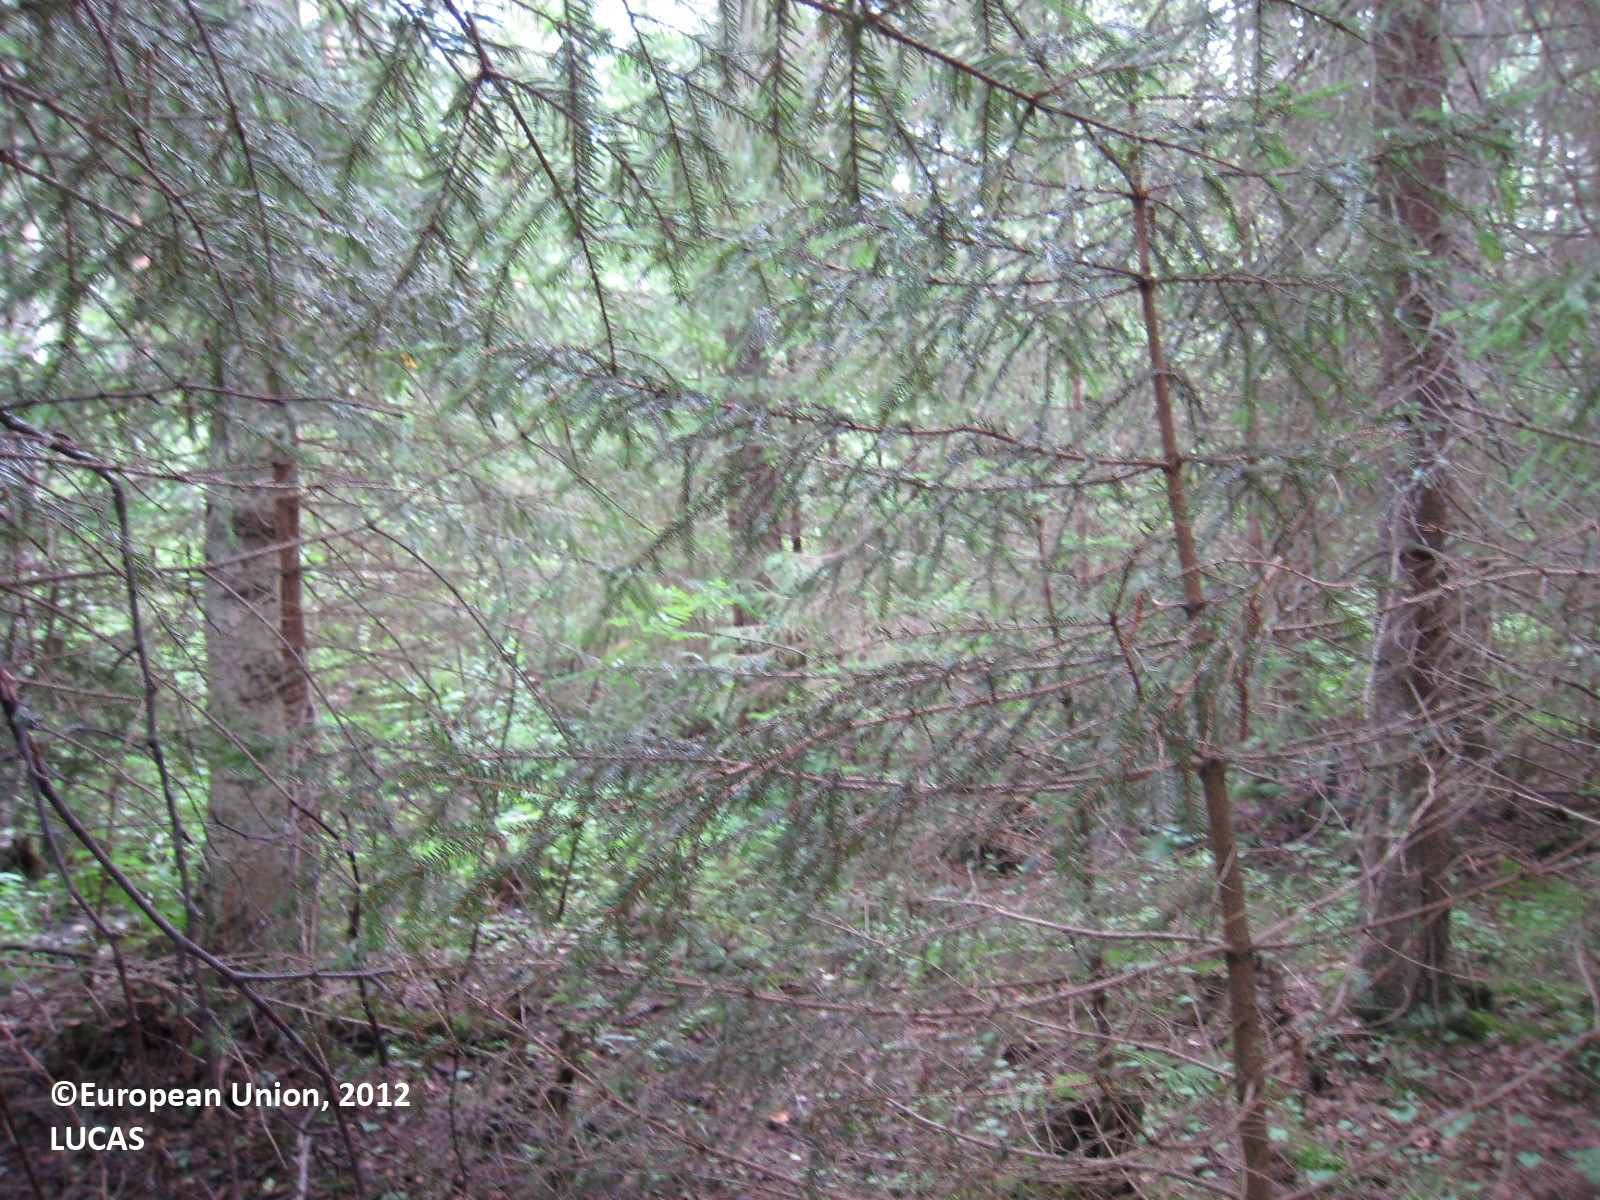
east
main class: Woodland
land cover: Spruce dominated mixed woodland
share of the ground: > 75 %
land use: Forestry
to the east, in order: Spruce dominated mixed woodland; Rivers and streams; Other mixed woodland; Tracks; Abandoned hedges; Ditches and canals; Spruce dominated mixed woodland; Tracks; Other coniferous woodland; Spruce dominated coniferous woodland; Ditches and canals; Spruce dominated mixed woodland
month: July
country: FI
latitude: 61.8981
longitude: 27.1177
